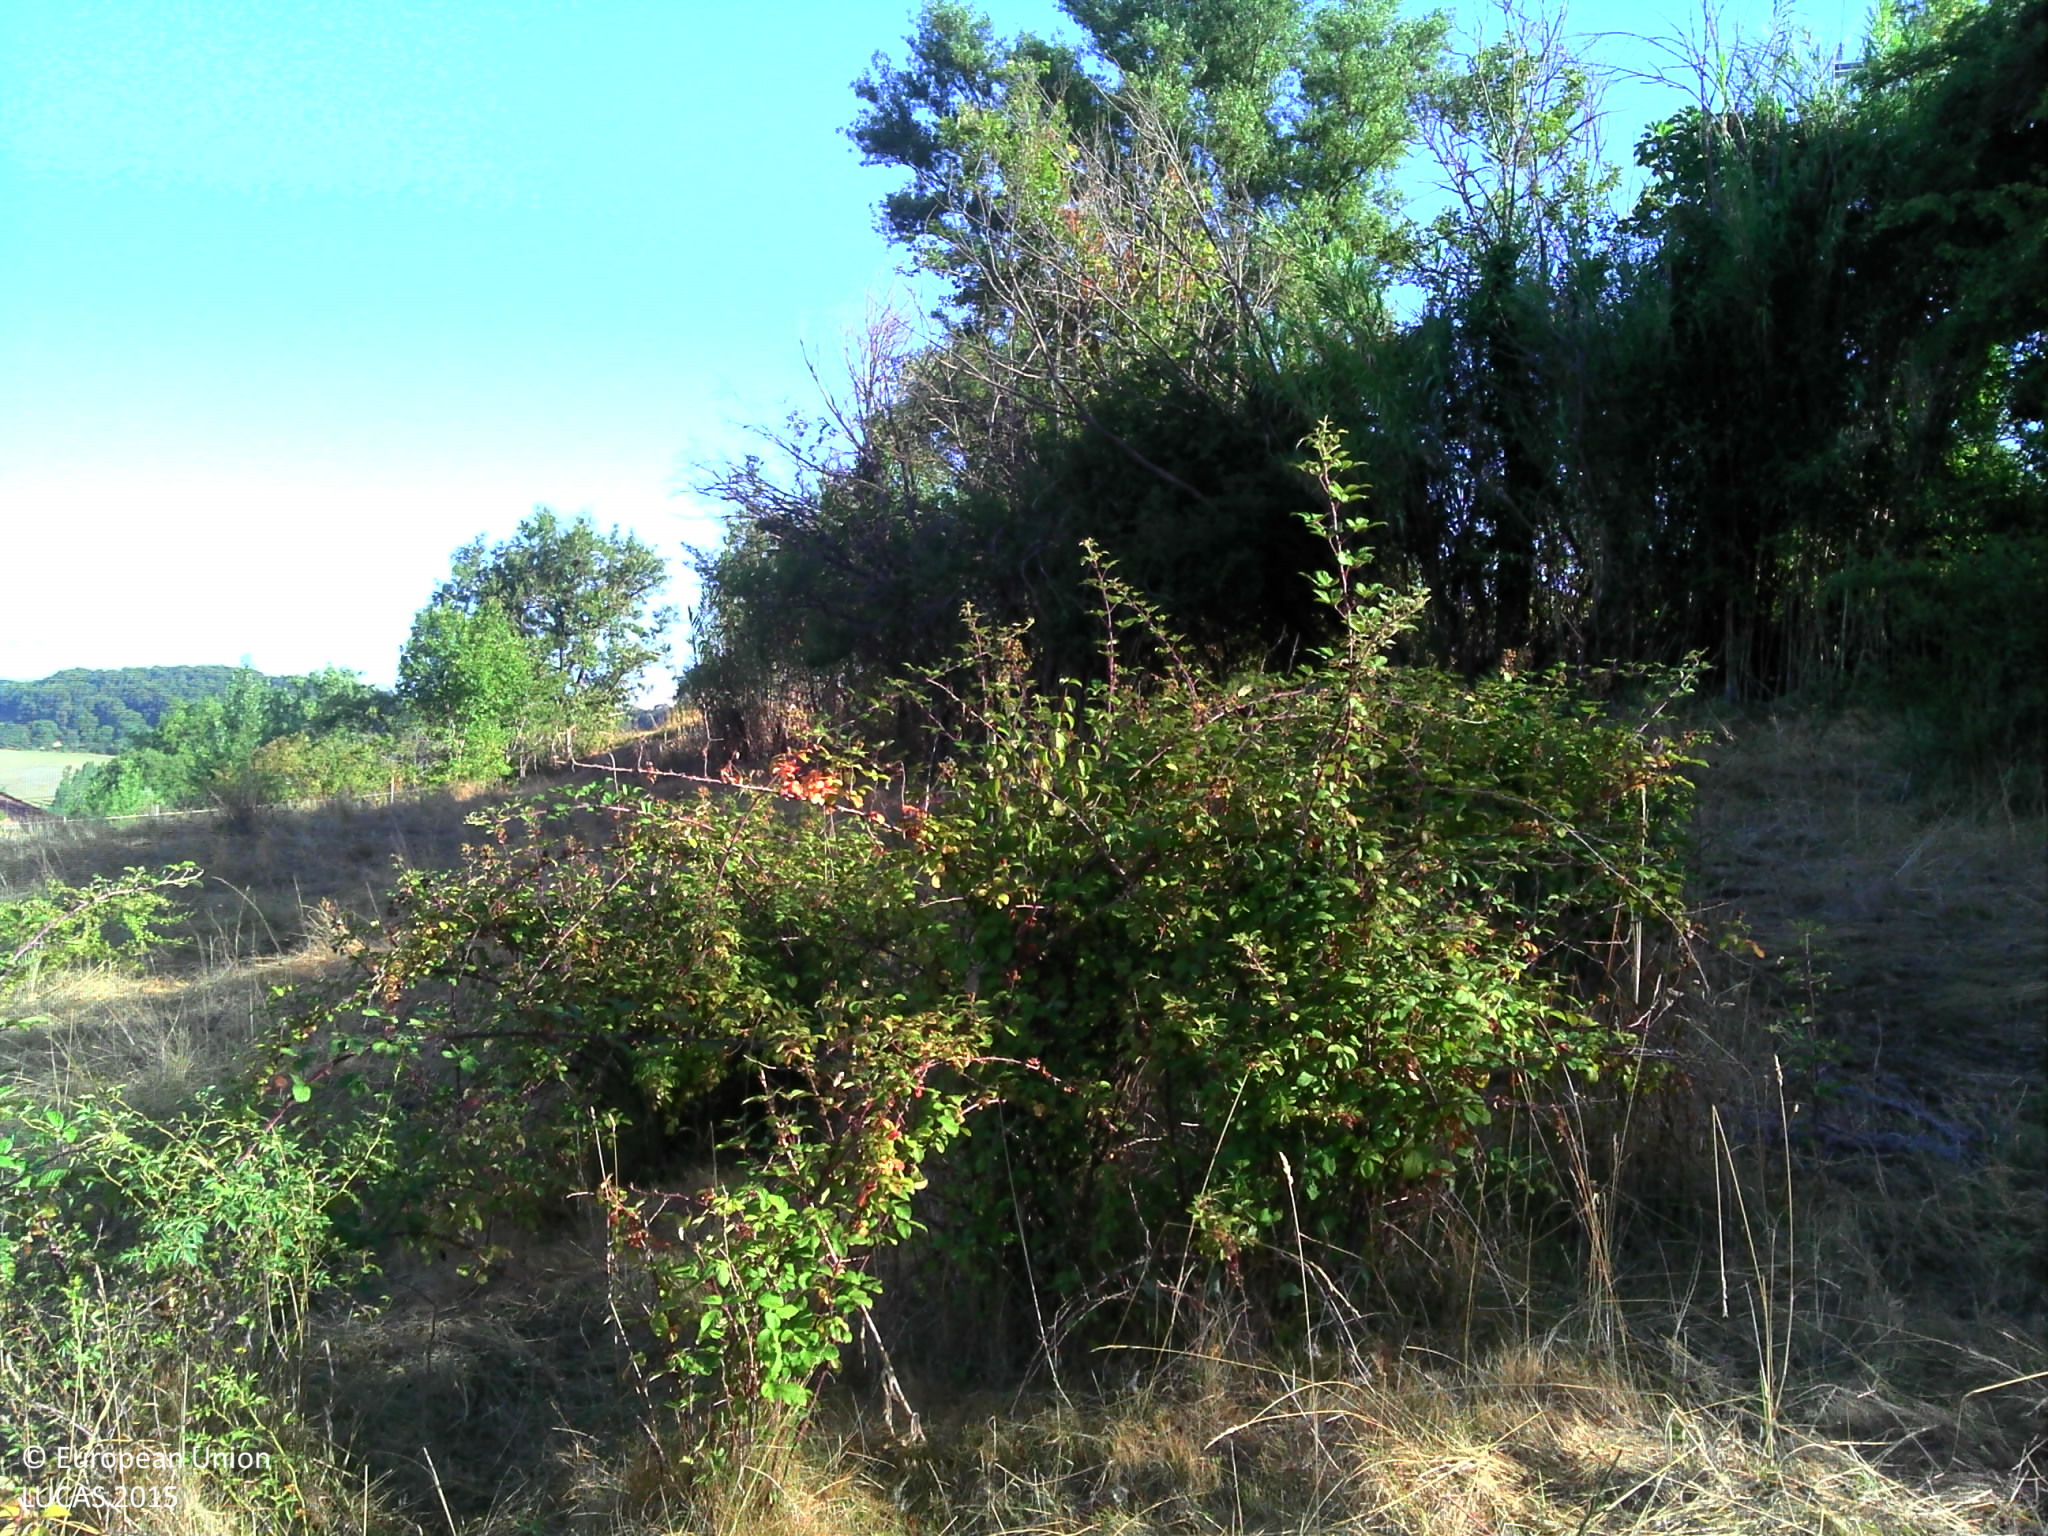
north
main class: Grassland
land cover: Grassland without tree/shrub cover
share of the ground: > 75 %
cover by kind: herbaceous plants 95 %, shrubs 5 %
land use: Agriculture (excluding fallow land and kitchen gardens)
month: July
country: FR
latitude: 44.3381
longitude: 0.5743
